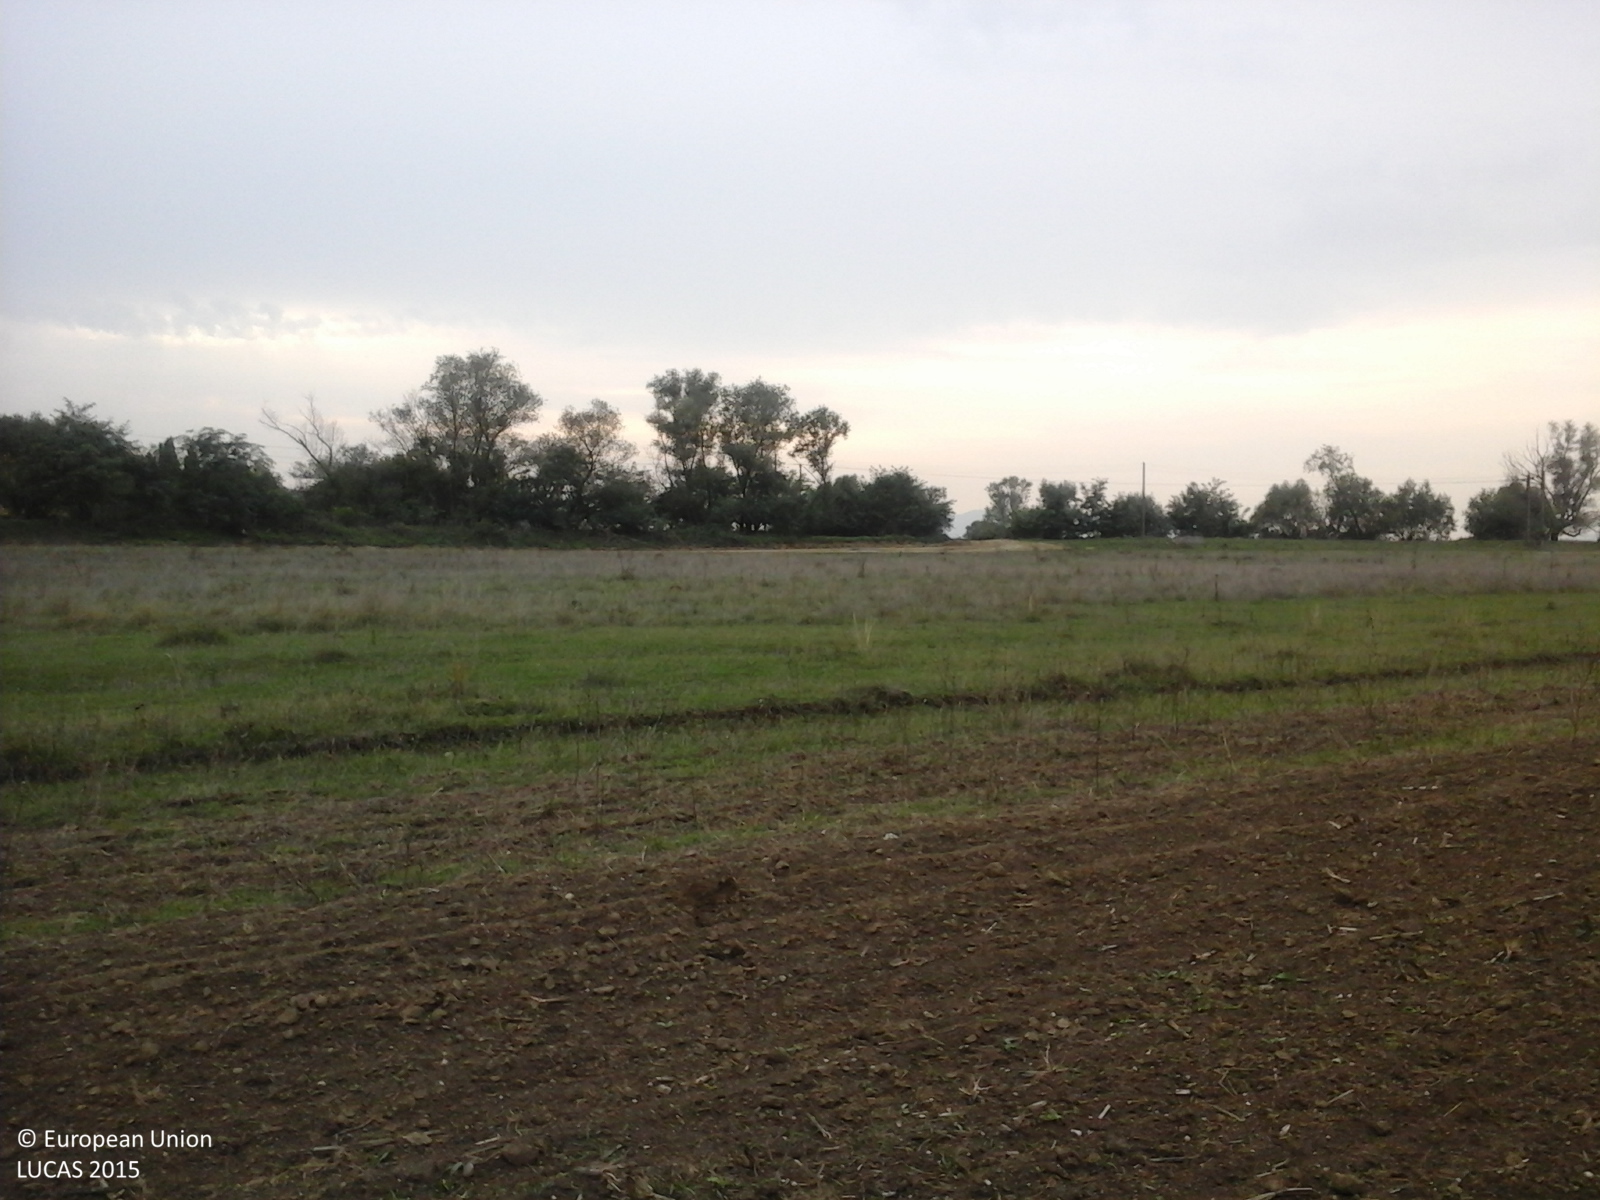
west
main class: Cropland
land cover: Maize
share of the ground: < 10 %
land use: Agriculture (excluding fallow land and kitchen gardens)
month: September
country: RO
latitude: 45.8367
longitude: 23.0725
